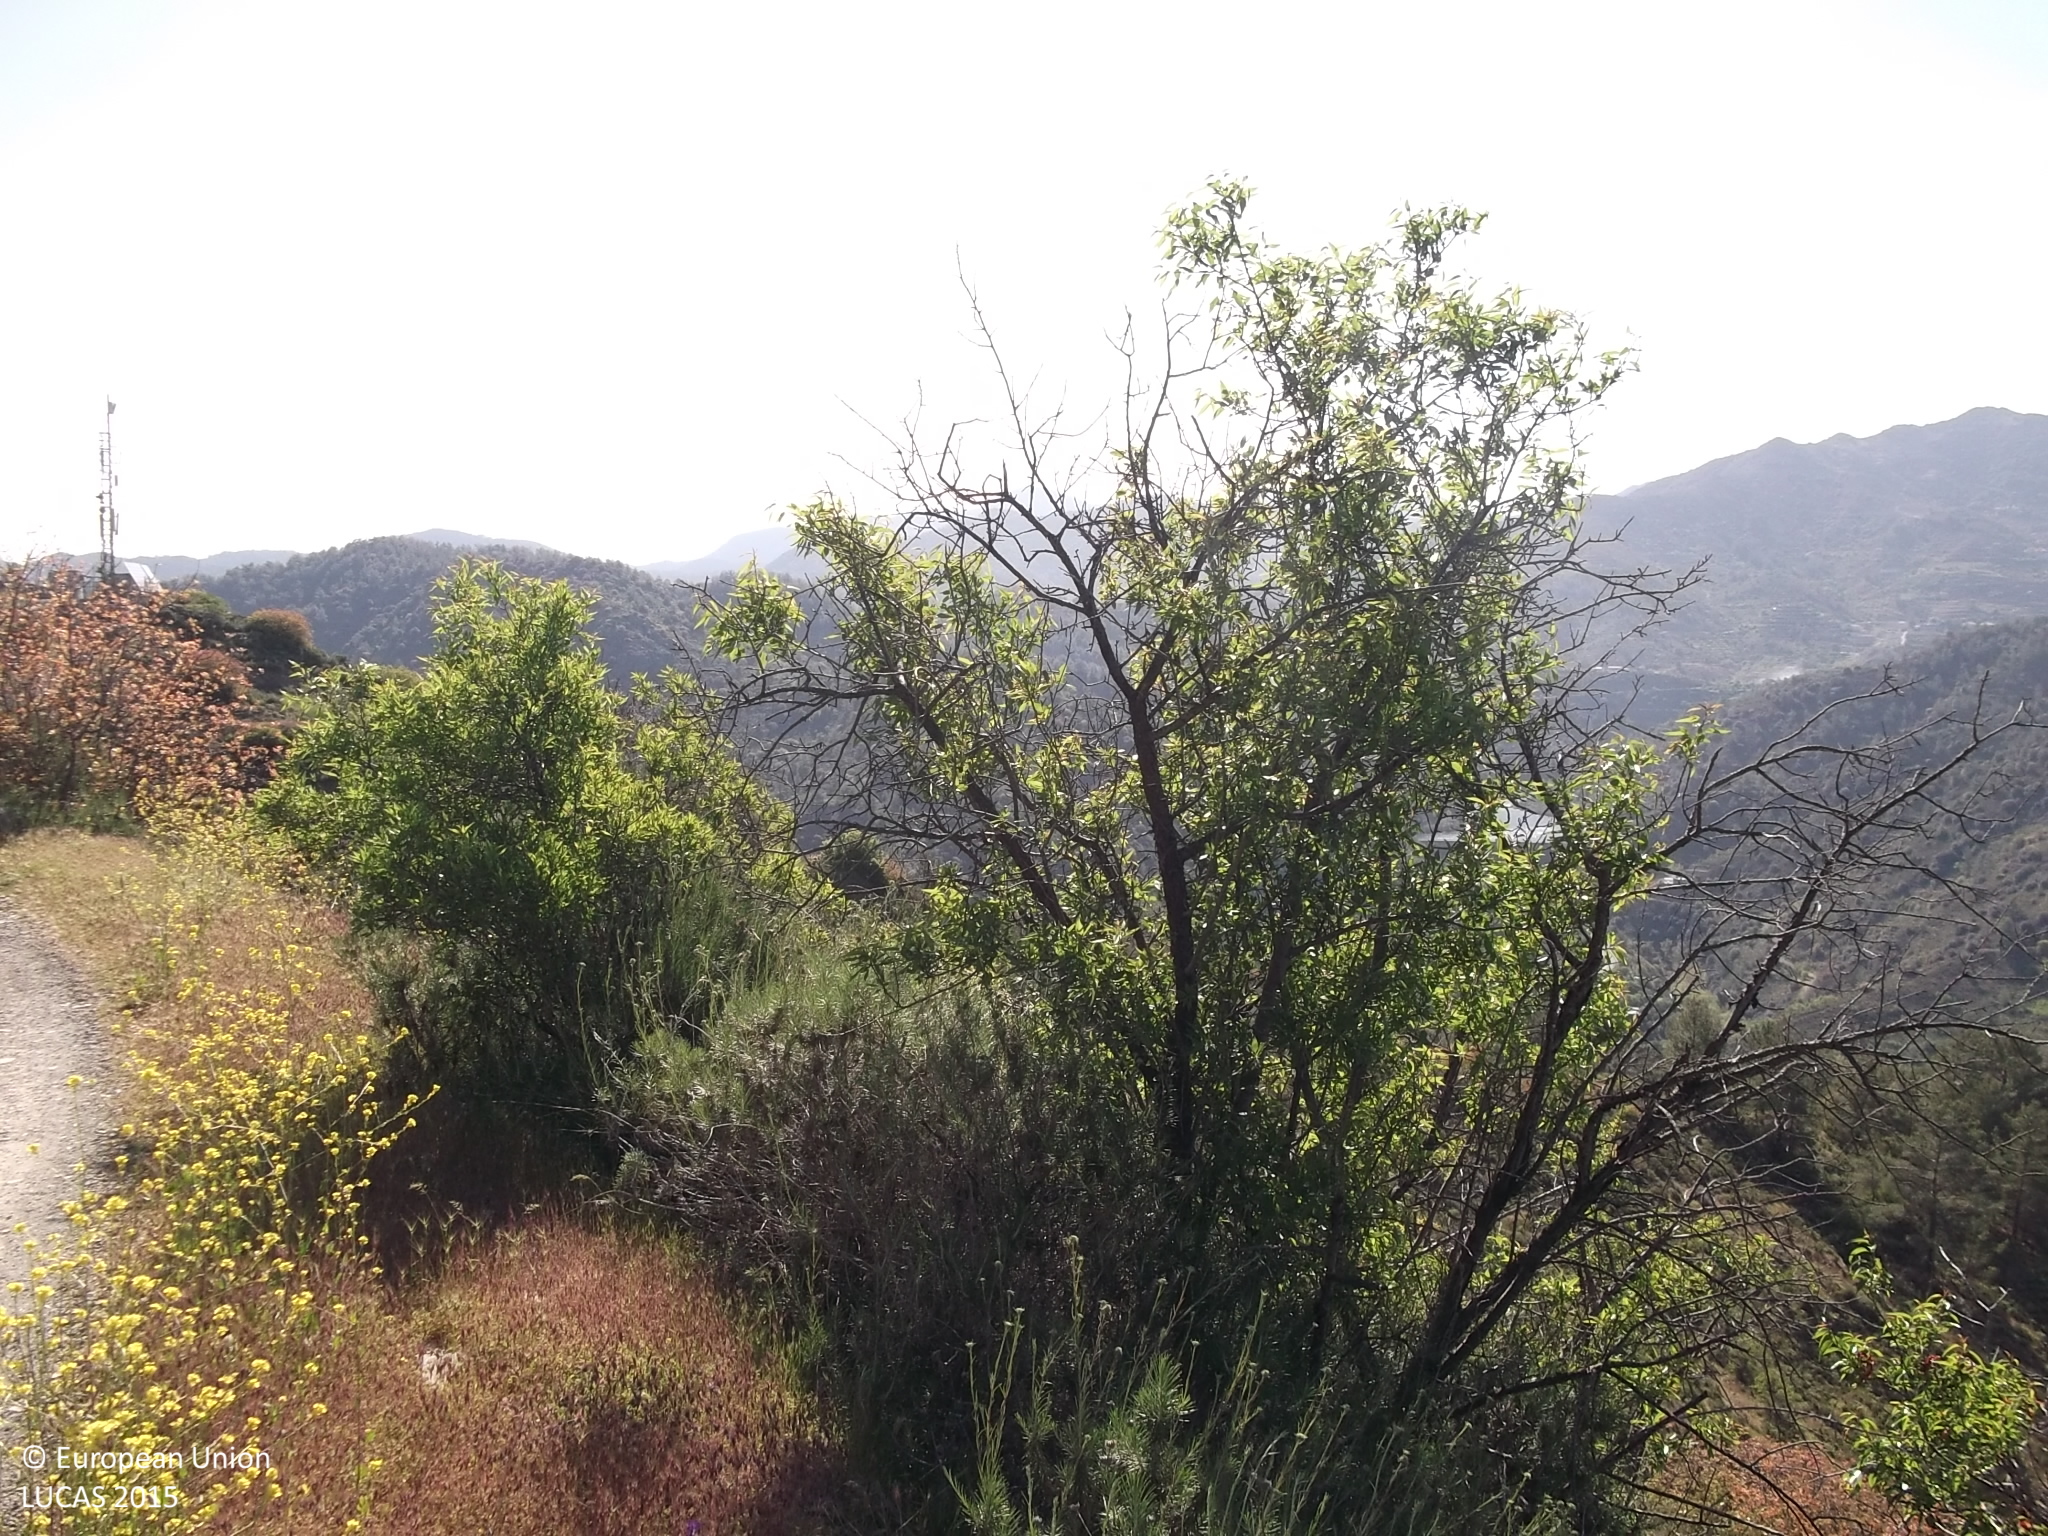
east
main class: Woodland
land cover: Pine dominated mixed woodland
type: coniferous forest of the mediterranean region
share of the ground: 10 - 25 %
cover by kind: shrubs 45 %, unconsolidated bare surface 30 %, coniferous forest trees 15 %, broadleaved forest trees 10 %
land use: Semi-natural and natural areas not in use
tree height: > 5 m
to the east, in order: Pine dominated mixed woodland; Shrubland with sparse tree cover; Shrubland without tree cover; Shrubland with sparse tree cover; Pine dominated coniferous woodland; Shrubland with sparse tree cover; Pine dominated coniferous woodland
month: April
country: CY
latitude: 34.9341
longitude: 33.1121
